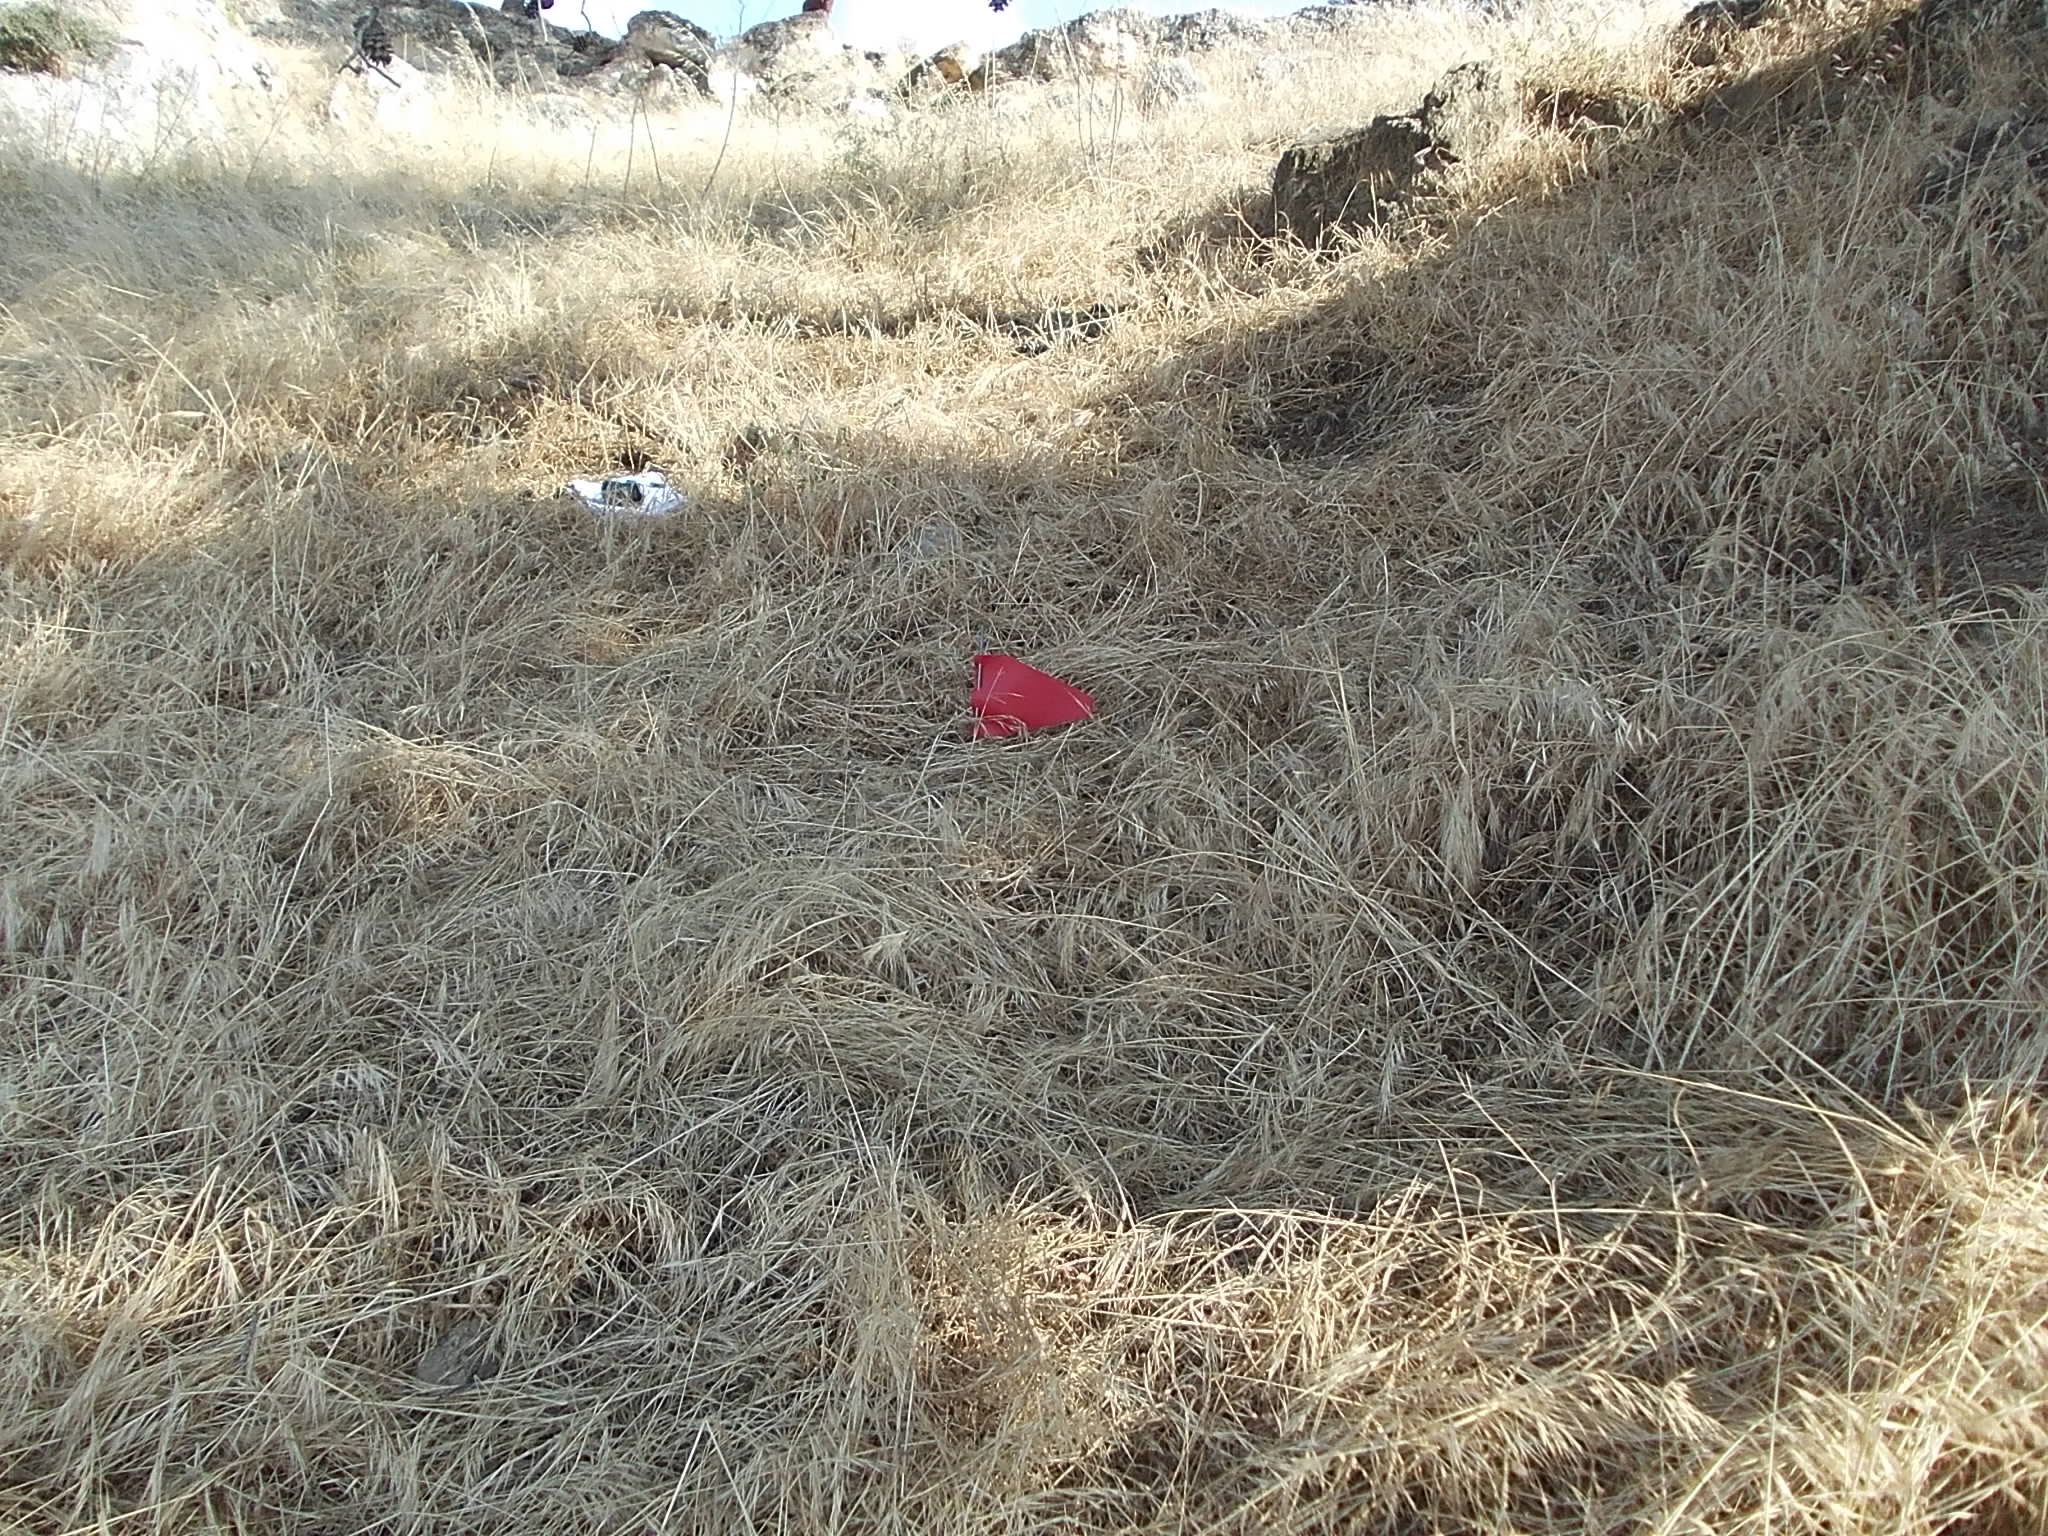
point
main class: Woodland
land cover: Pine dominated coniferous woodland
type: coniferous forest of the mediterranean region
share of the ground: 25 - 50 %
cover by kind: herbaceous plants 50 %, coniferous forest trees 35 %, consolidated bare surface 15 %
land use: Semi-natural and natural areas not in use
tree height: > 5 m
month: June
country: CY
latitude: 34.6676
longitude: 32.6857
